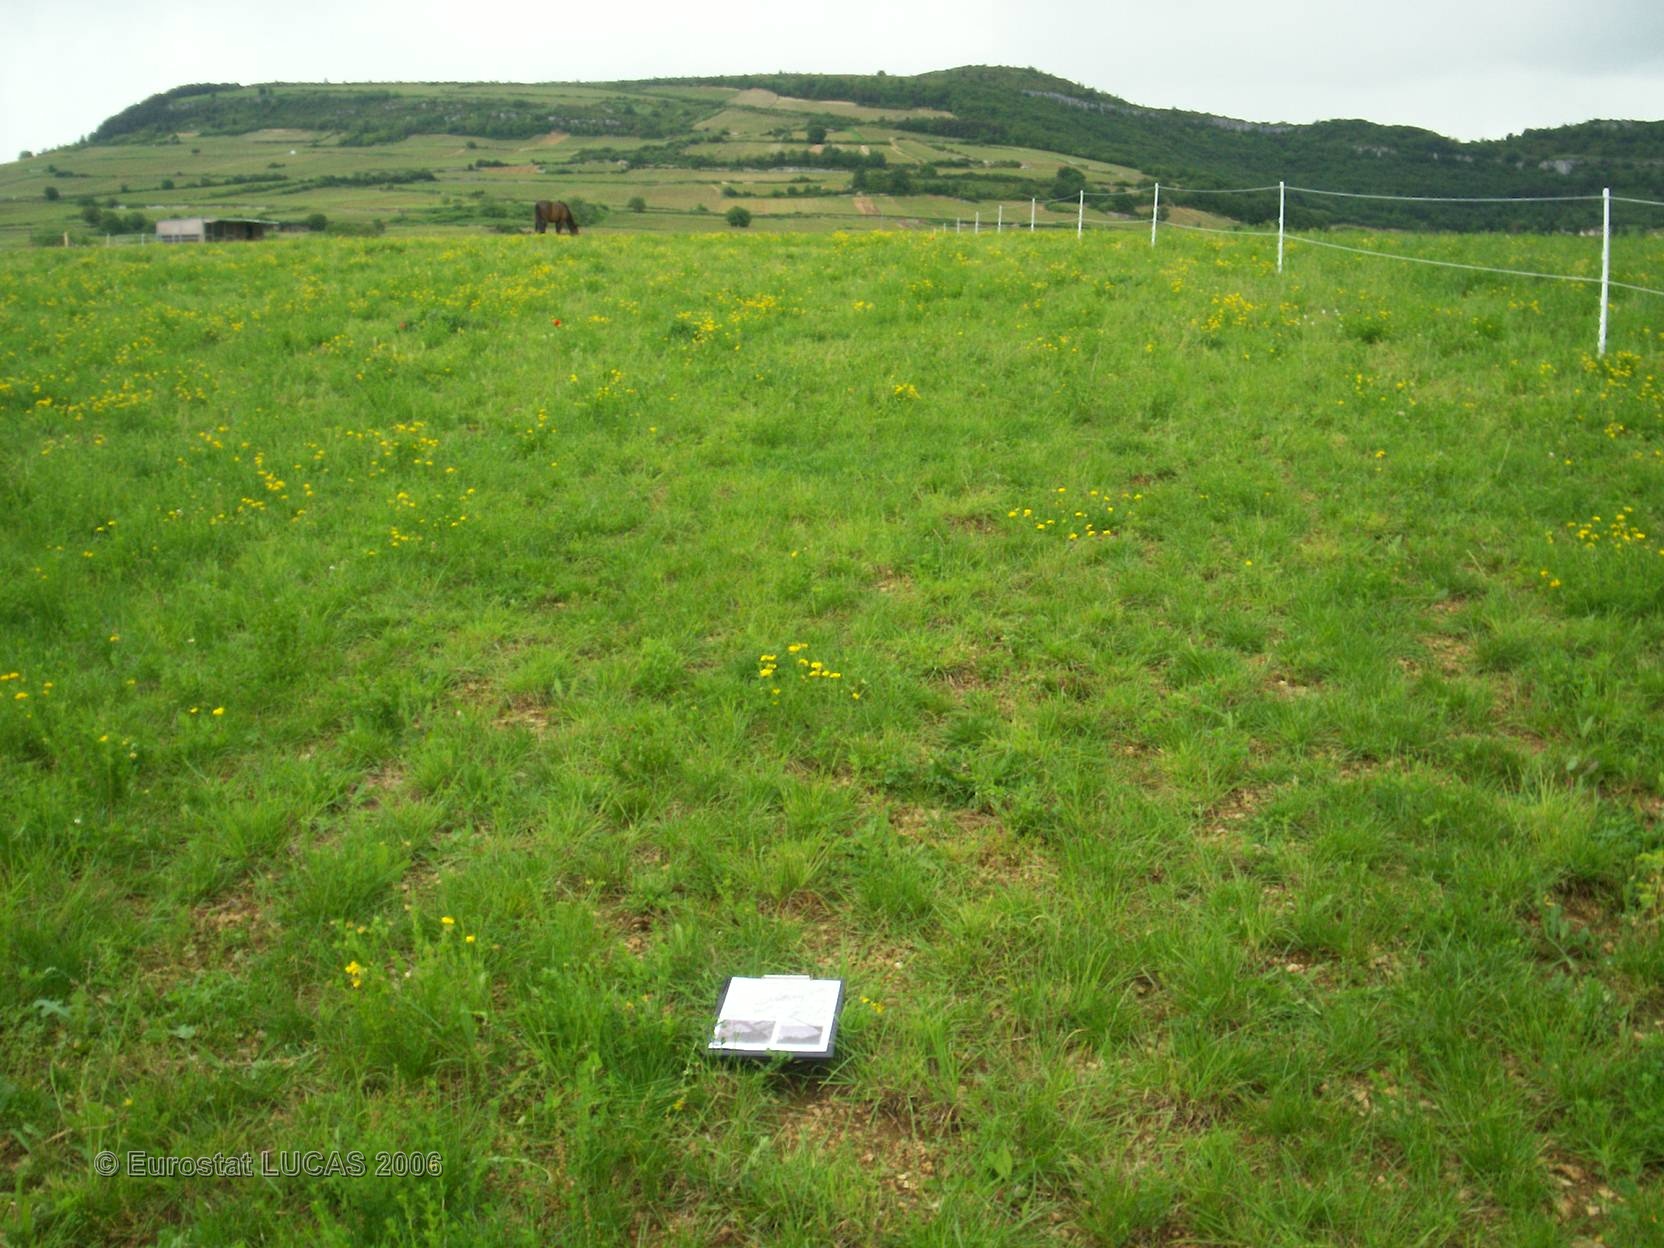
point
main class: Grassland
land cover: Grassland without tree/shrub cover
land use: Agriculture (excluding fallow land and kitchen gardens)
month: May
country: FR
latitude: 46.9048
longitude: 4.6839
